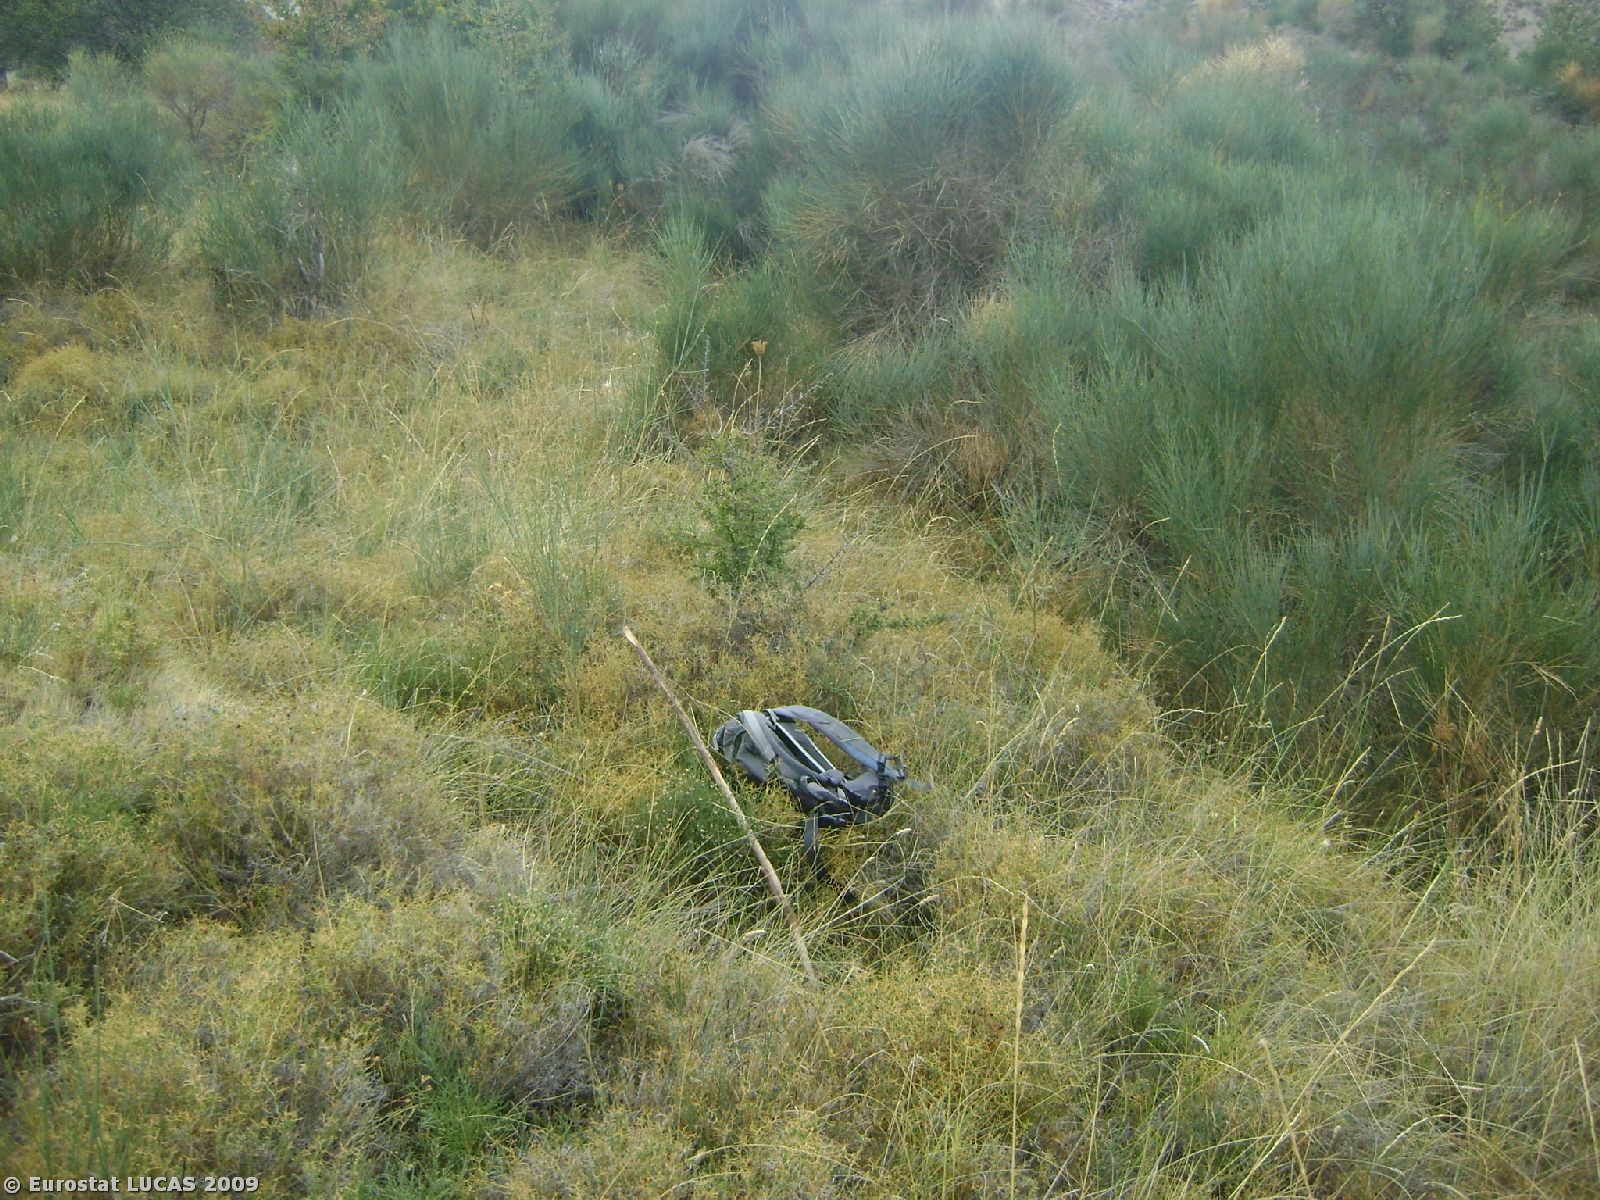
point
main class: Shrubland
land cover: Shrubland with sparse tree cover
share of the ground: > 75 %
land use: Unused
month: October
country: GR
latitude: 38.1181
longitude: 22.2998
